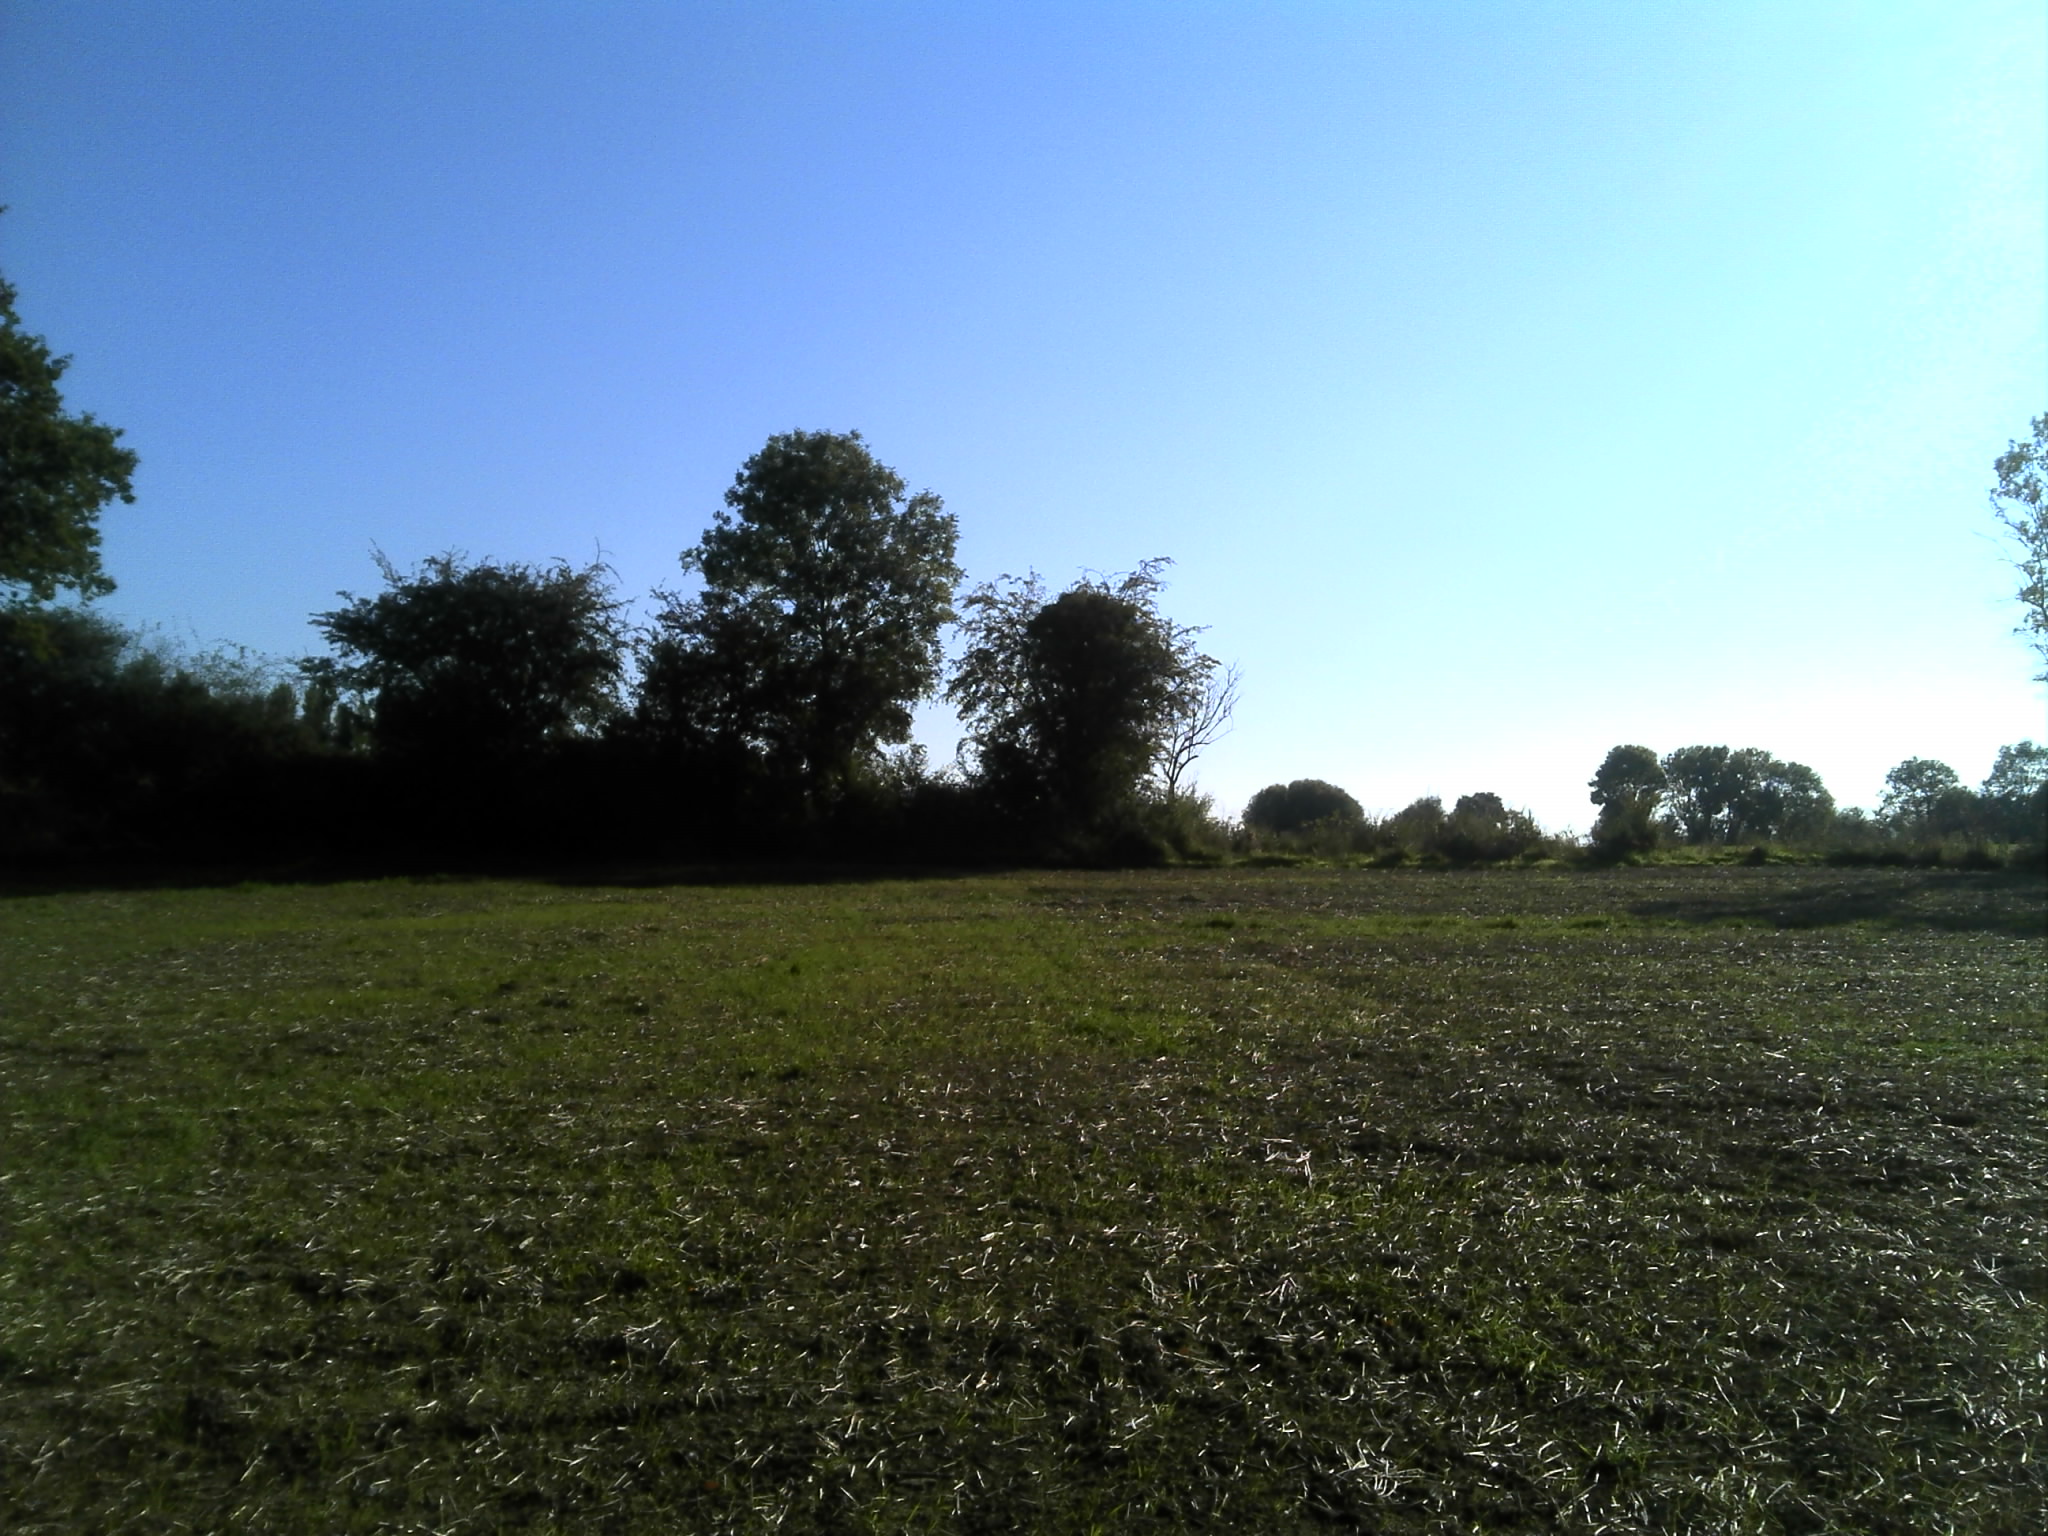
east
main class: Cropland
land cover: Temporary grasslands
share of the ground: > 75 %
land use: Agriculture (excluding fallow land and kitchen gardens)
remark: Harvested field
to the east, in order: Temporary grasslands; Abandoned hedges; Temporary grasslands; Fences; Grass margins; Paved roads, cycling and walking lanes; Grass margins; Fences; Managed hedges; Inland fresh water bodies; Grassland without tree/shrub cover; Fences; Ditches and canals; Grass margins; Paved roads, cycling and walking lanes; Grass margins; Ditches and canals; Managed hedges; Maize; Abandoned hedges
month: October
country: FR
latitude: 47.6279
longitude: -1.0699
